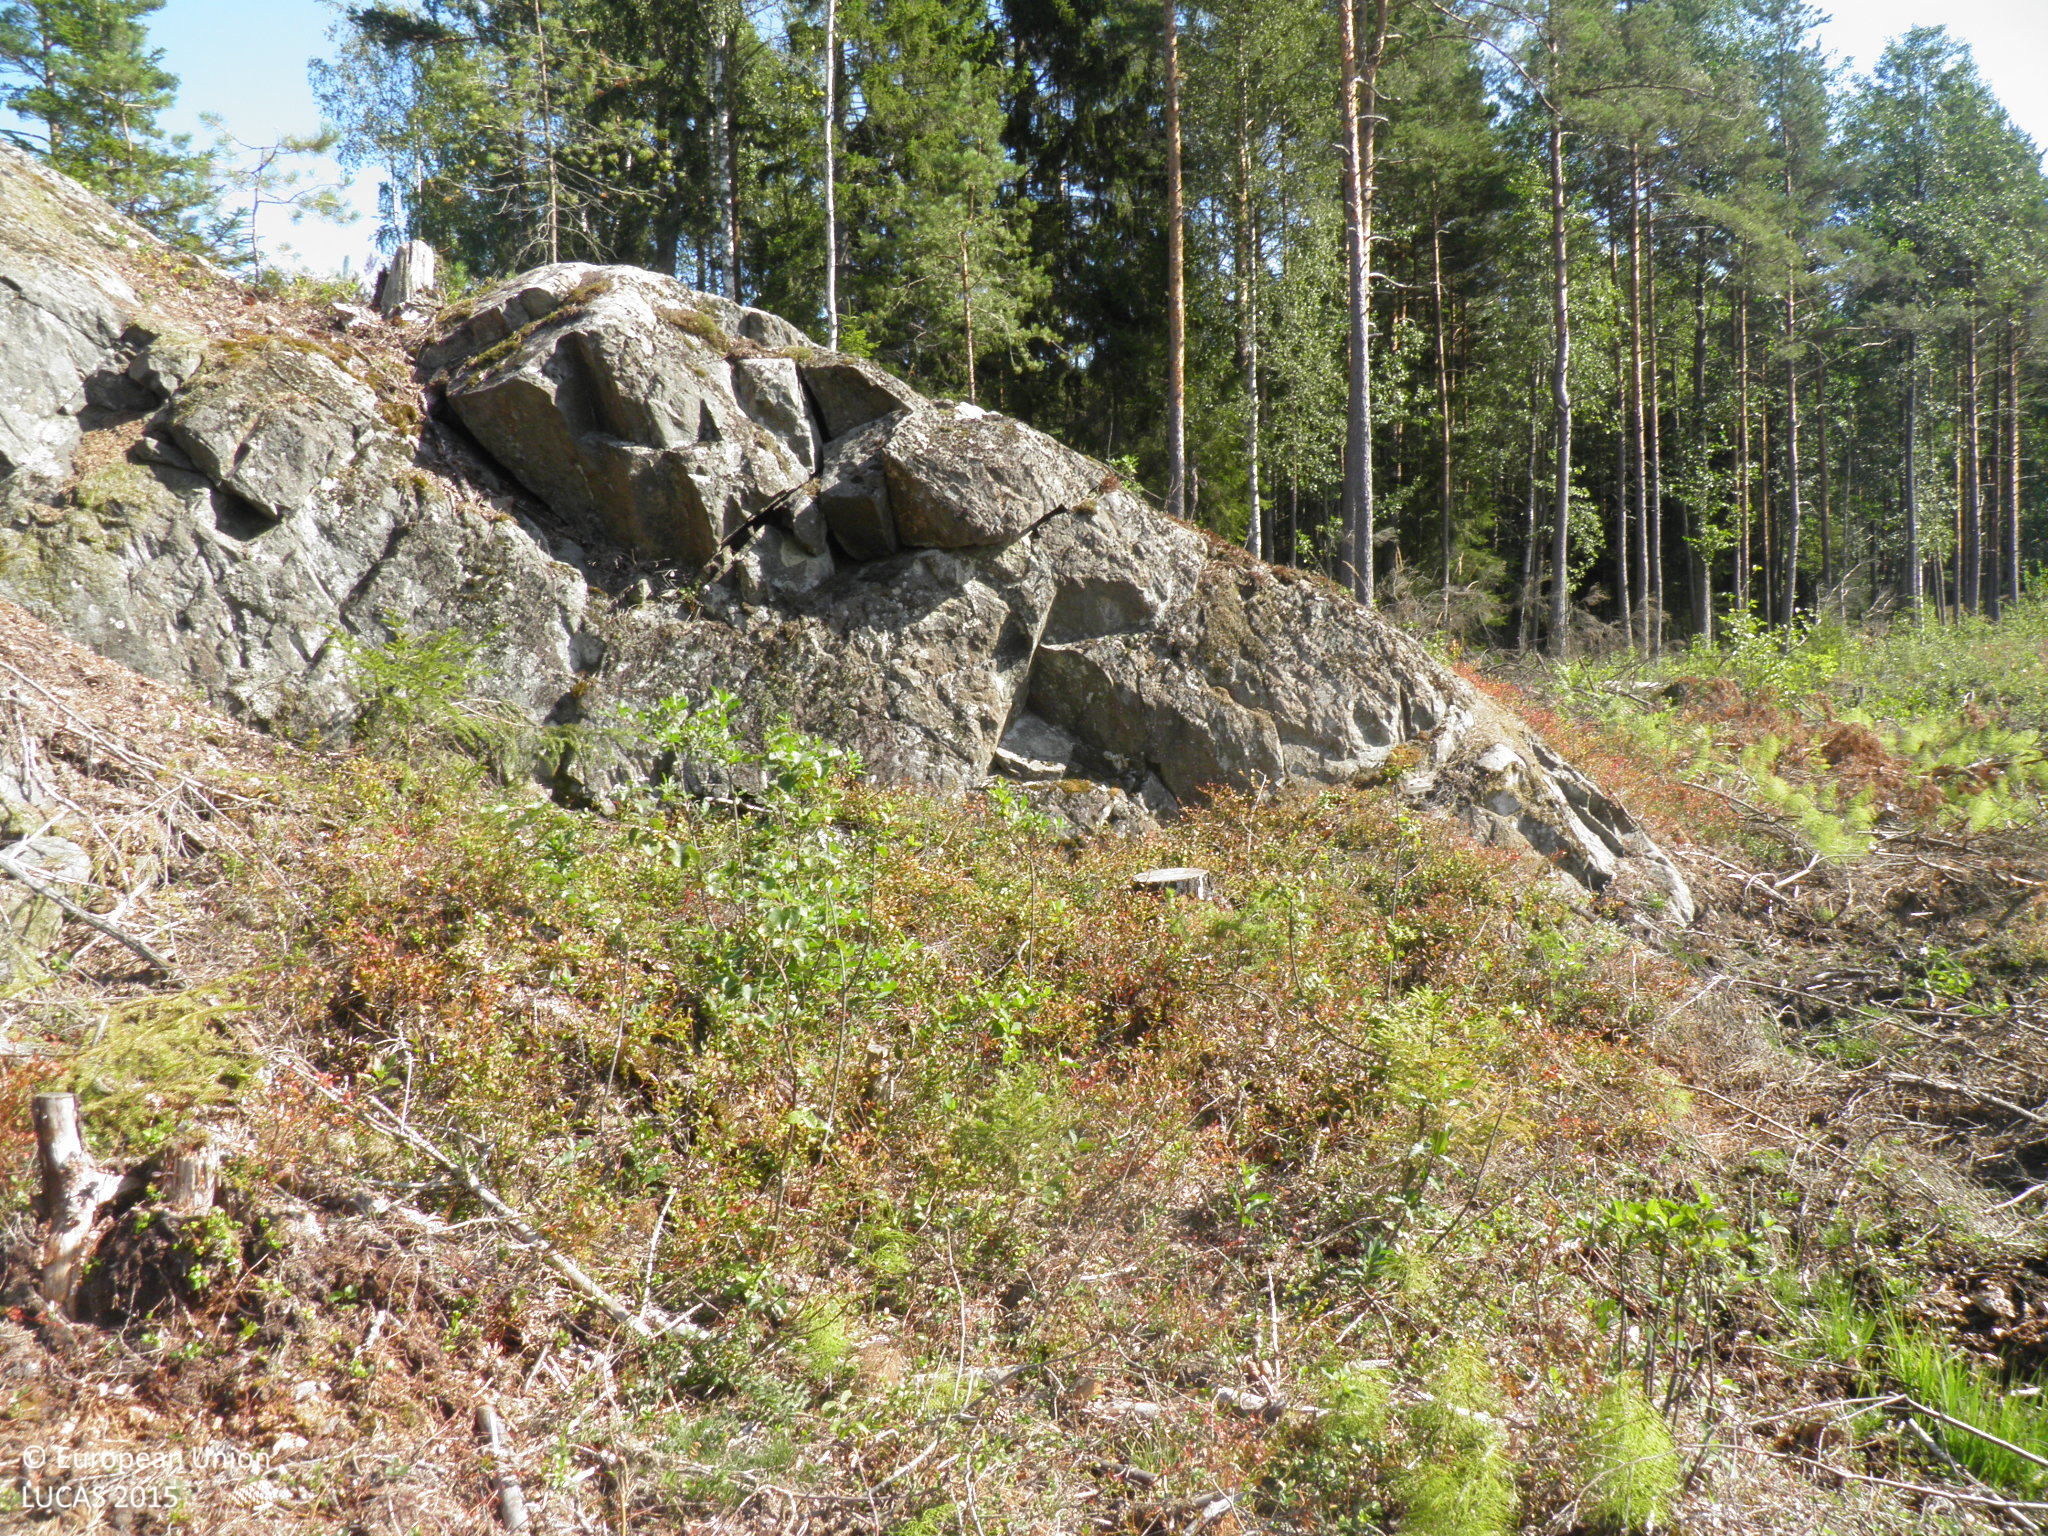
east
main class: Grassland
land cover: Spontaneously vegetated surfaces
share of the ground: 10 - 25 %
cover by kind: unconsolidated bare surface 50 %, consolidated bare surface 15 %, herbaceous plants 10 %, shrubs 5 %
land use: Forestry
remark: Clear cut
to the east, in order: Spontaneously vegetated surfaces; Pine dominated mixed woodland; Ditches and canals; Pine dominated mixed woodland; Ditches and canals; Other mixed woodland
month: August
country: FI
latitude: 60.0568
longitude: 22.7392
